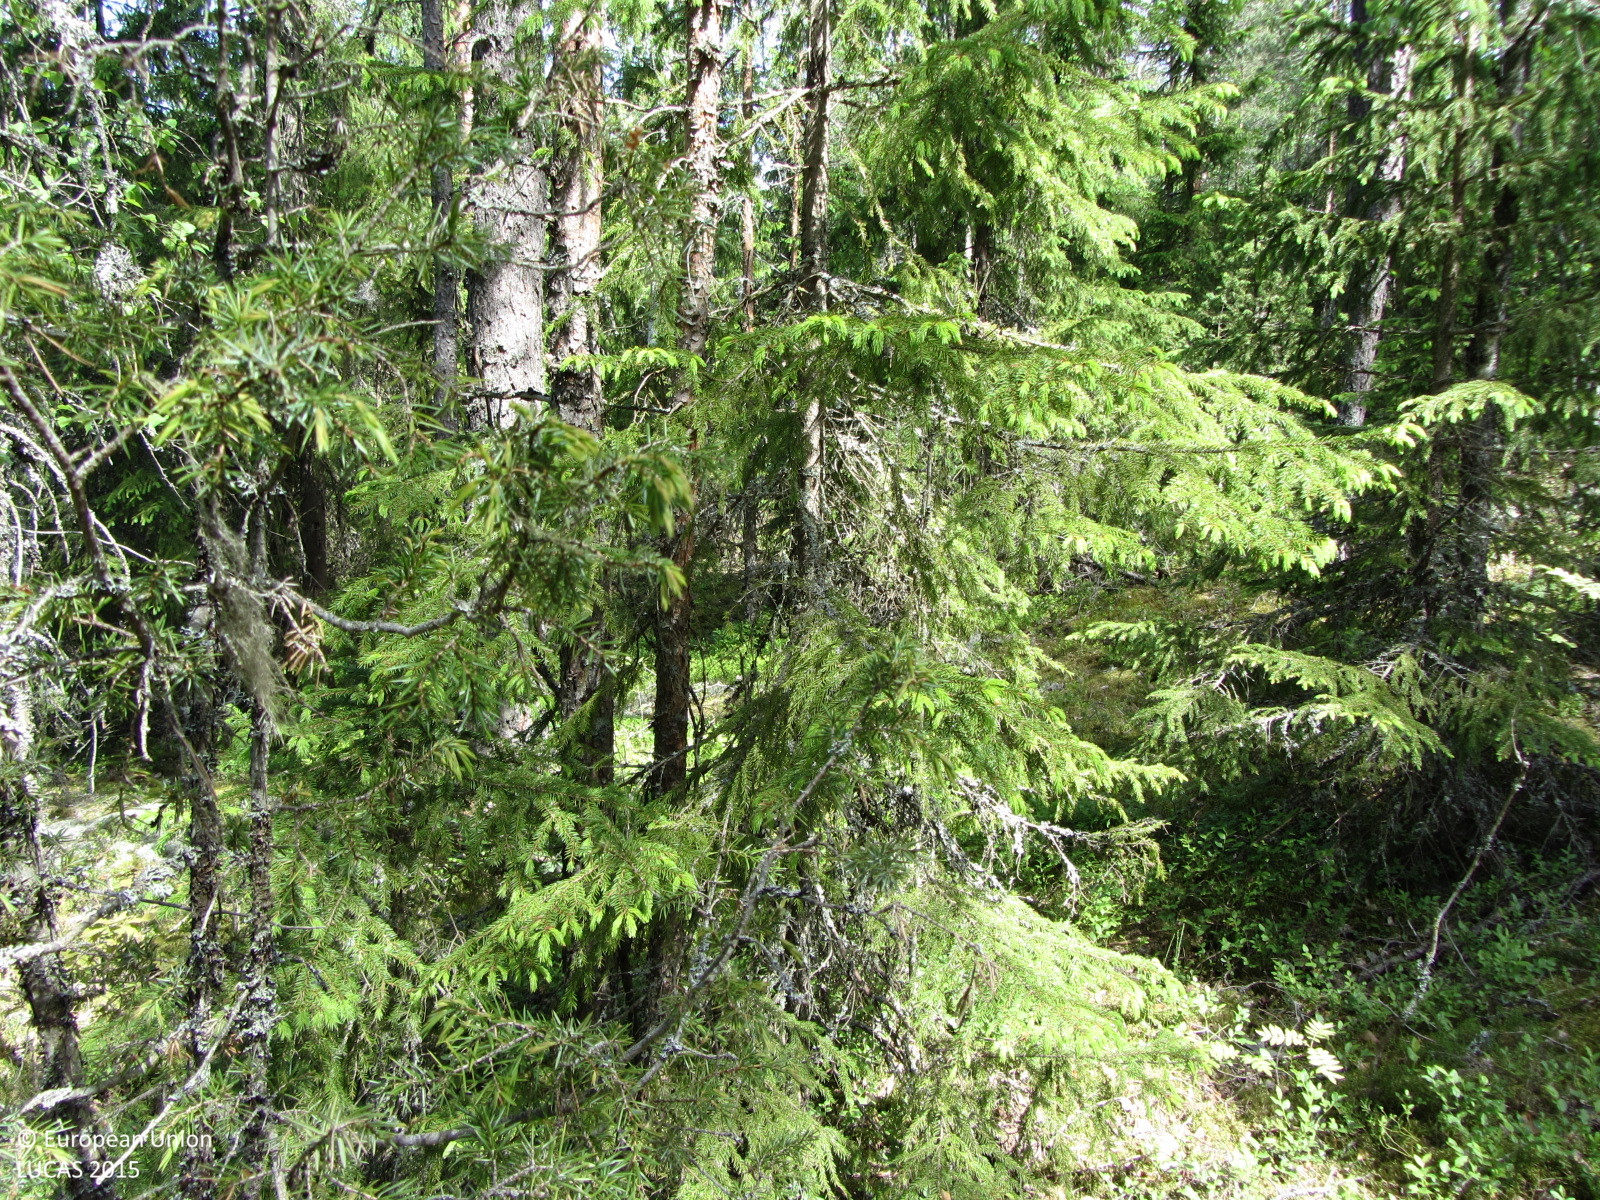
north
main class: Woodland
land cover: Pine dominated coniferous woodland
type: boreal forest
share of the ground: > 75 %
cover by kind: coniferous forest trees 65 %, lichens and mosses 20 %, broadleaved forest trees 10 %, shrubs 5 %
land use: Forestry
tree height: > 5 m
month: June
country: FI
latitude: 60.4203
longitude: 24.2861
